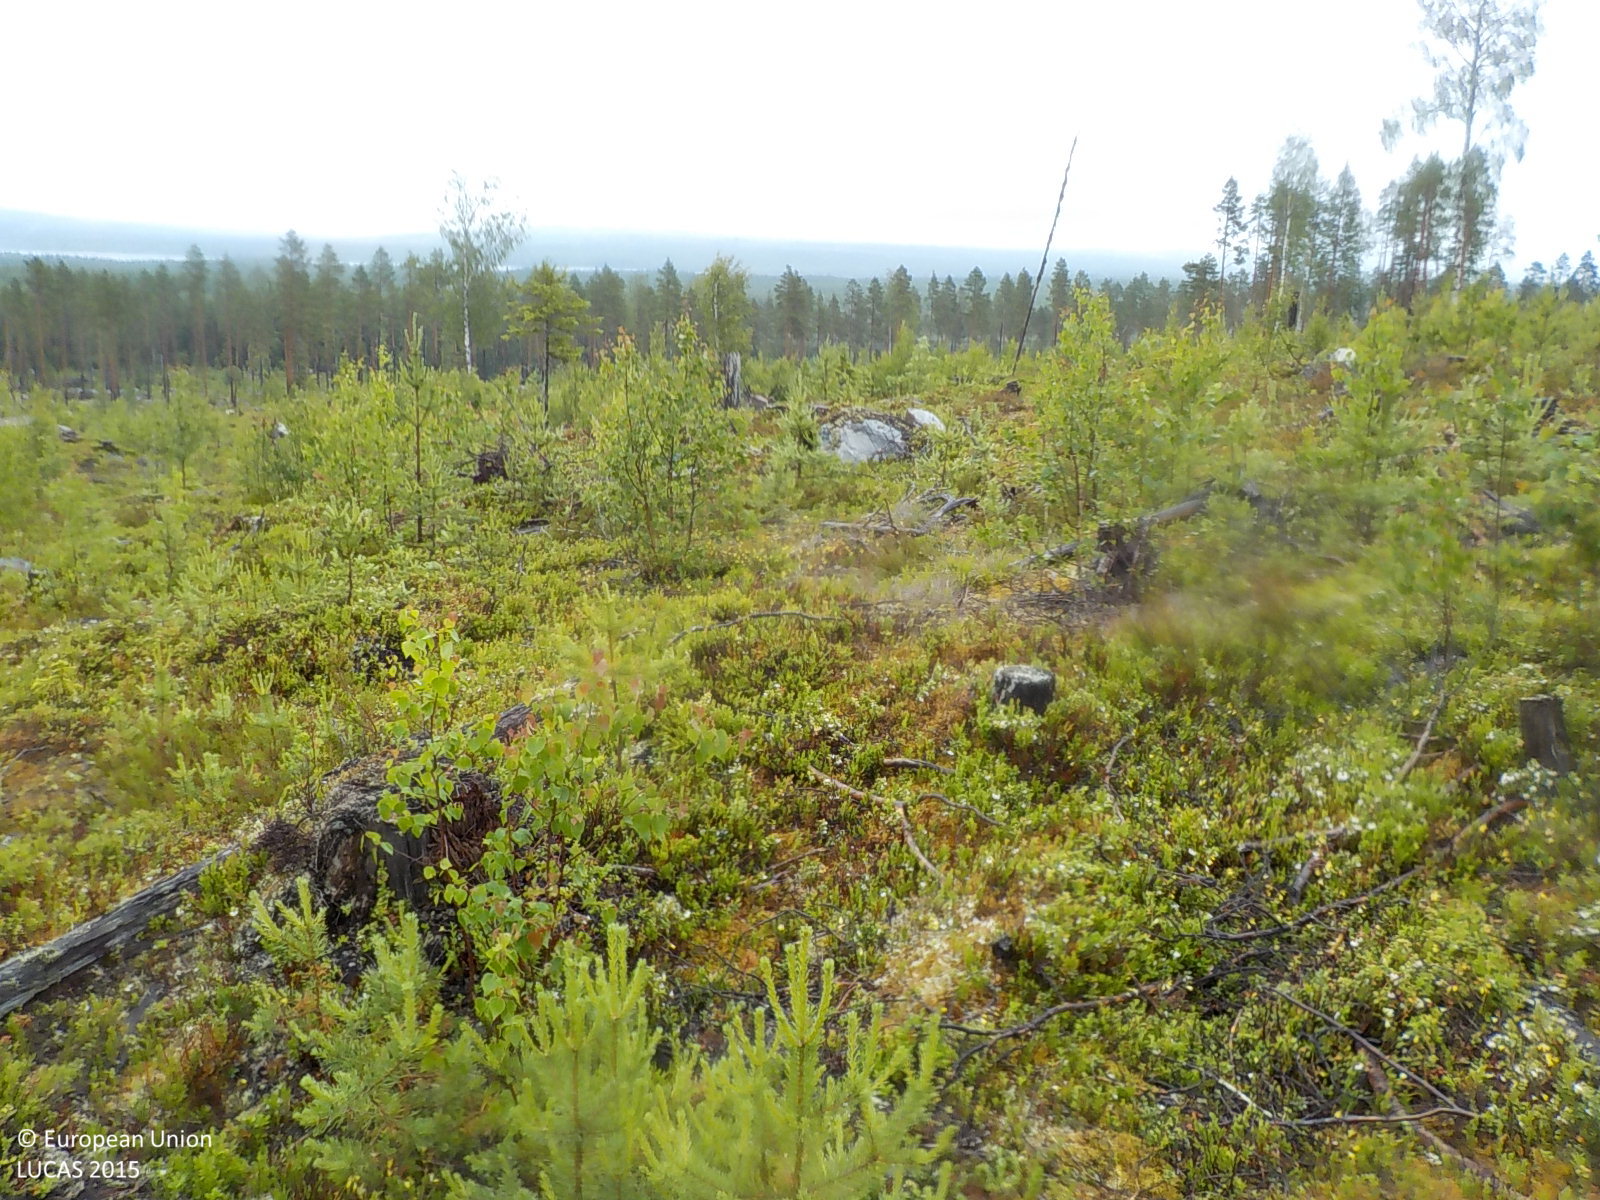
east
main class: Woodland
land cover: Other mixed woodland
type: boreal forest
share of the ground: 50 - 75 %
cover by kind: shrubs 50 %, coniferous forest trees 30 %, broadleaved forest trees 20 %
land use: Forestry
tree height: < 5 m
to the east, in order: Other mixed woodland; Shrubland with sparse tree cover; Broadleaved woodland; Paved roads, cycling and walking lanes; Broadleaved woodland; Pine dominated coniferous woodland
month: July
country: SE
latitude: 63.0116
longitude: 16.9883
